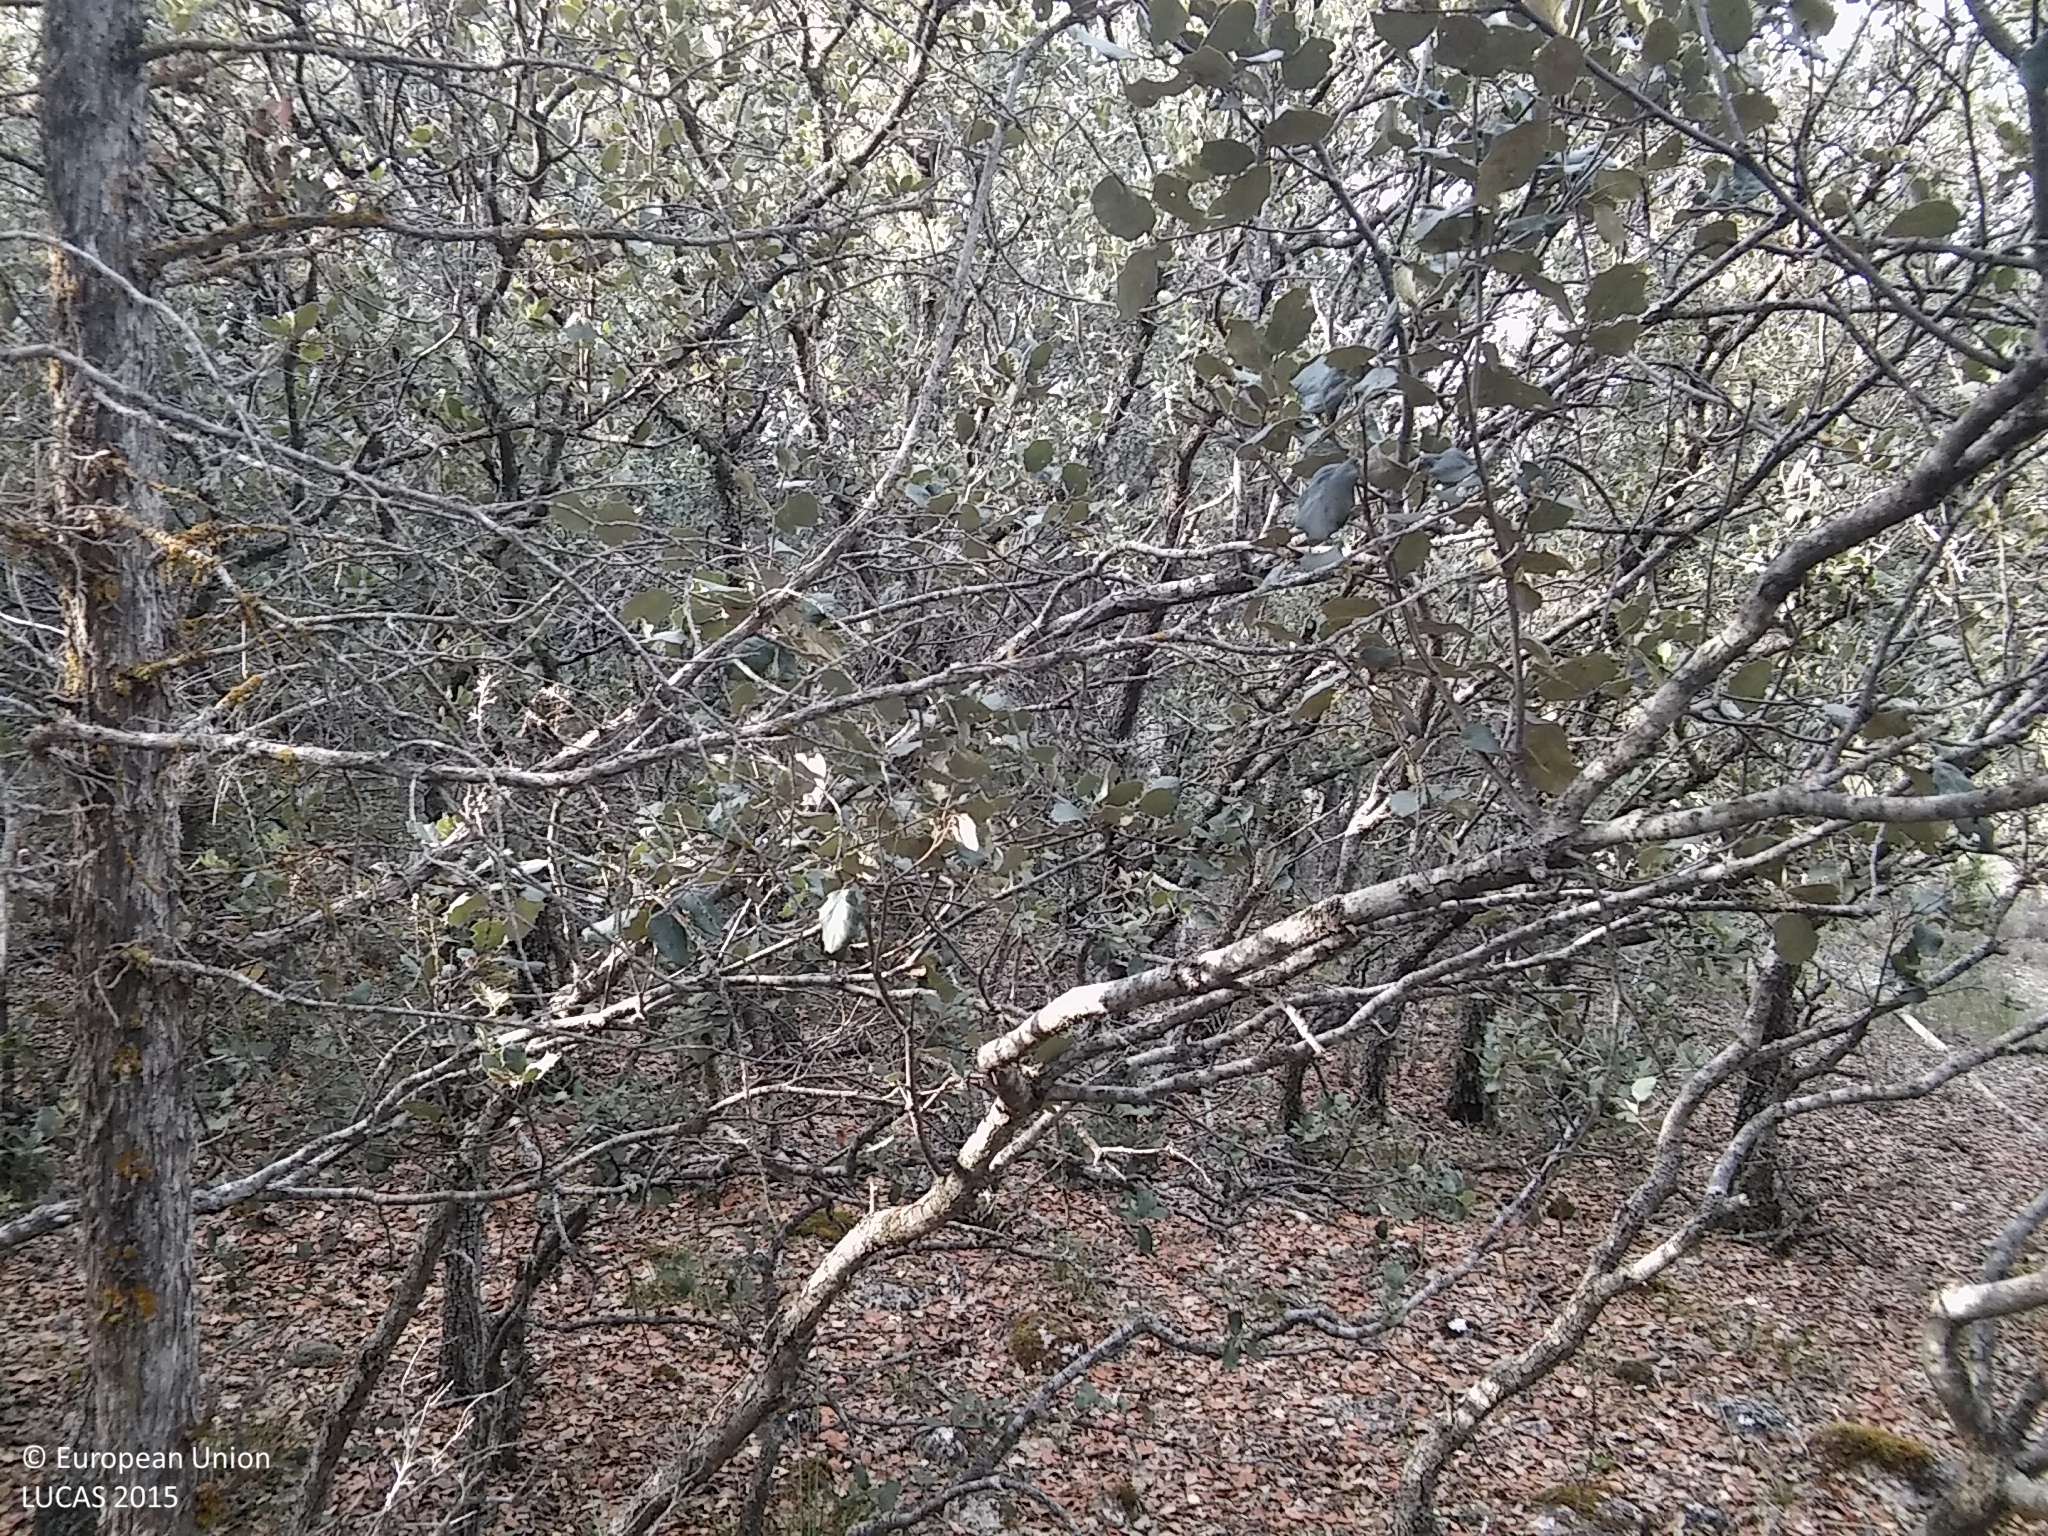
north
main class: Woodland
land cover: Broadleaved woodland
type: broadleaved evergreen forest
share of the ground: 50 - 75 %
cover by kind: broadleaved forest trees 70 %, unconsolidated bare surface 25 %, herbaceous plants 5 %
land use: Semi-natural and natural areas not in use
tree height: > 5 m
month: July
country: ES
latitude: 41.5720
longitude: -3.5657
